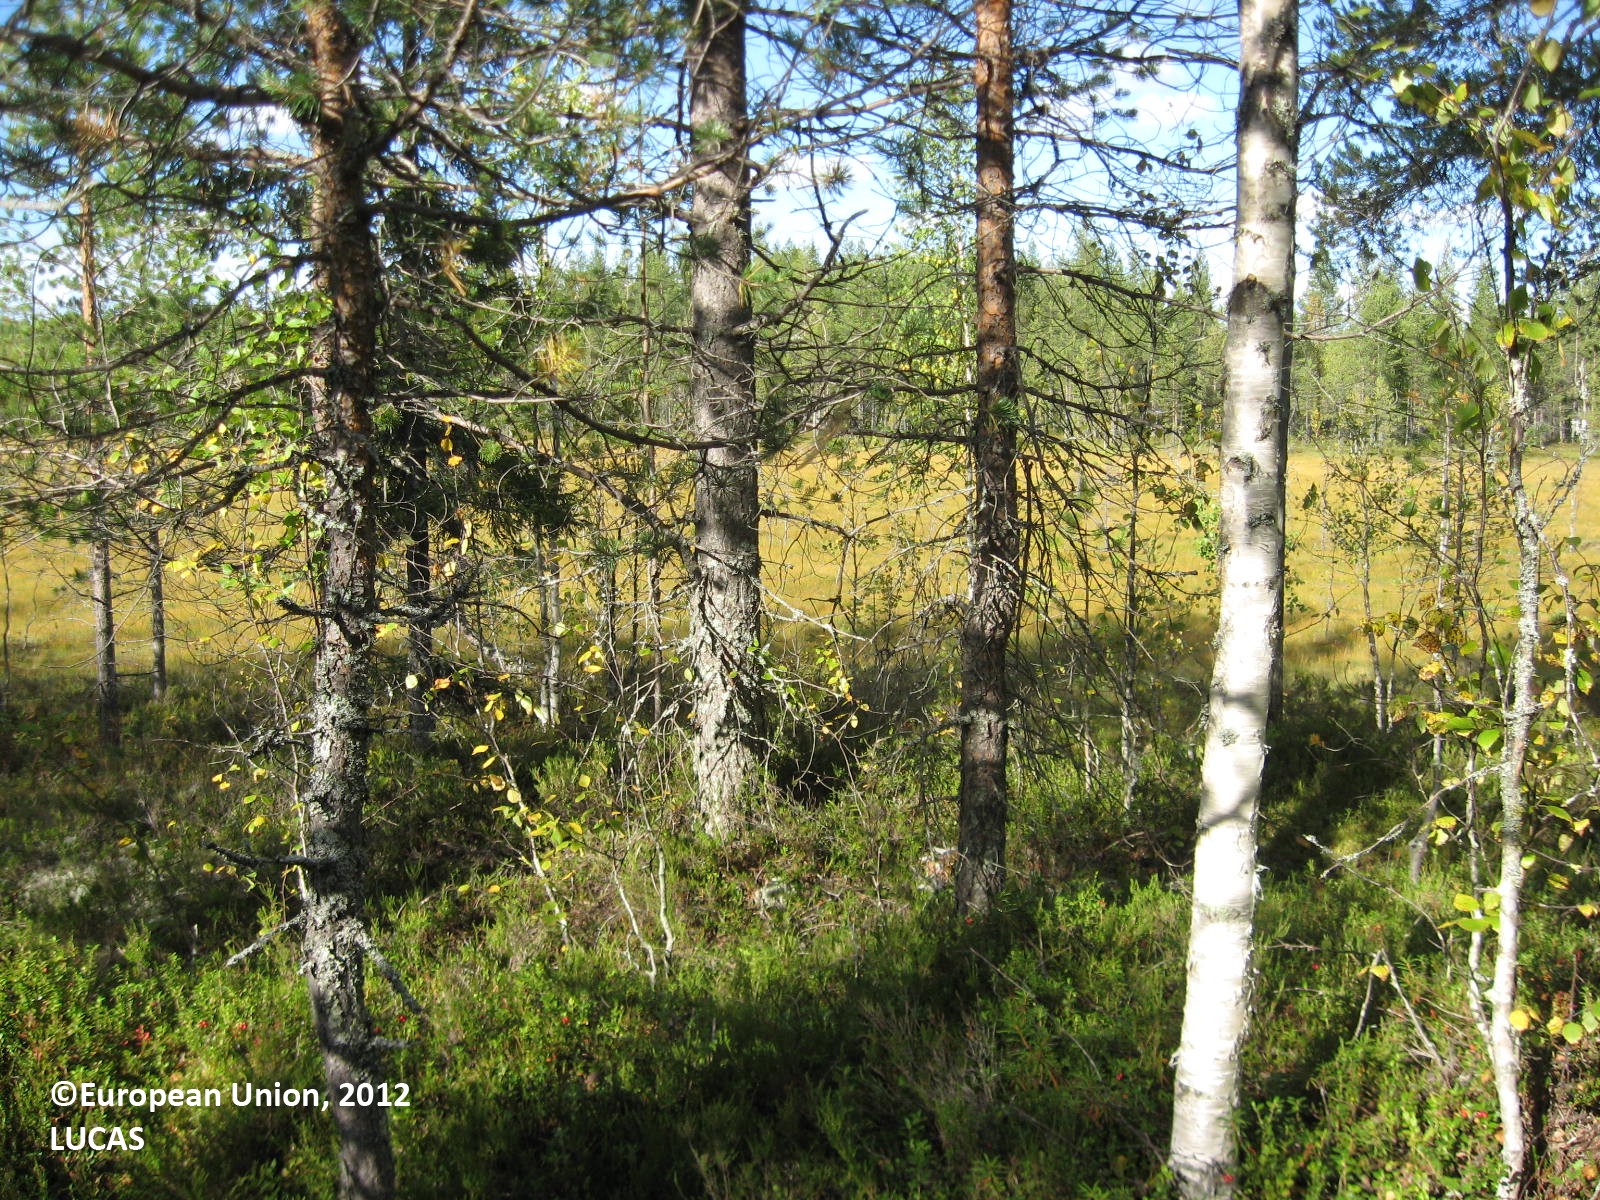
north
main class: Woodland
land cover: Pine dominated mixed woodland
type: boreal forest
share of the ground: > 75 %
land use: Forestry
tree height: > 5 m
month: August
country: FI
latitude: 63.8474
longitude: 29.6061
